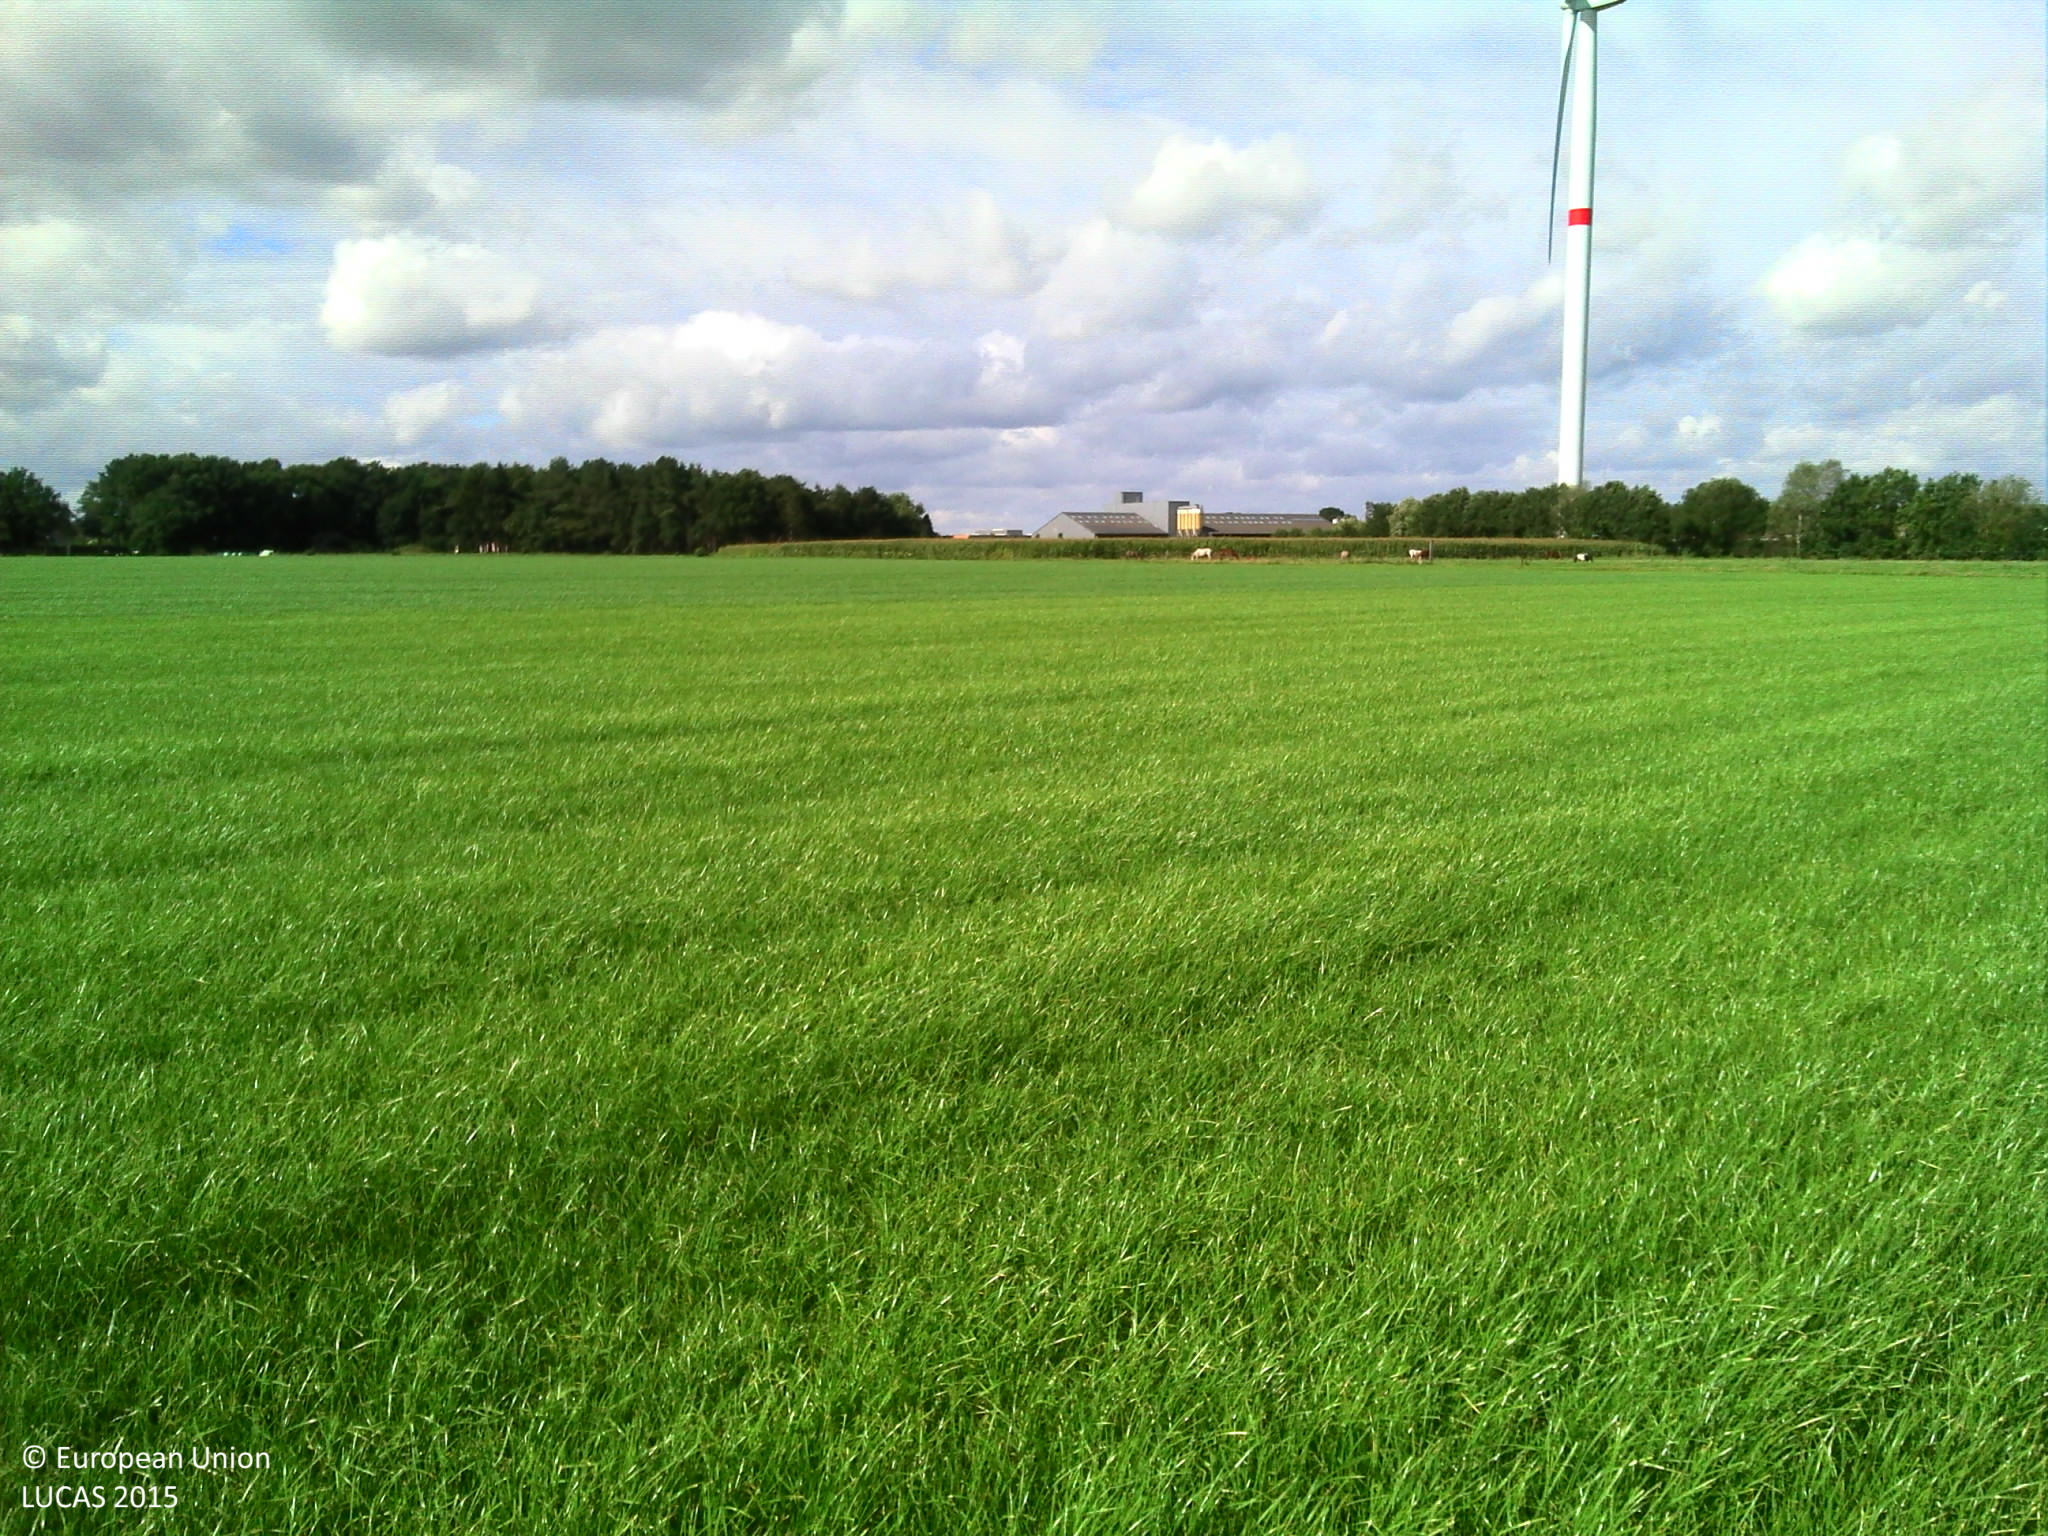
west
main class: Cropland
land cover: Temporary grasslands
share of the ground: > 75 %
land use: Agriculture (excluding fallow land and kitchen gardens)
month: September
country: BE
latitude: 51.4399
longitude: 4.5145
